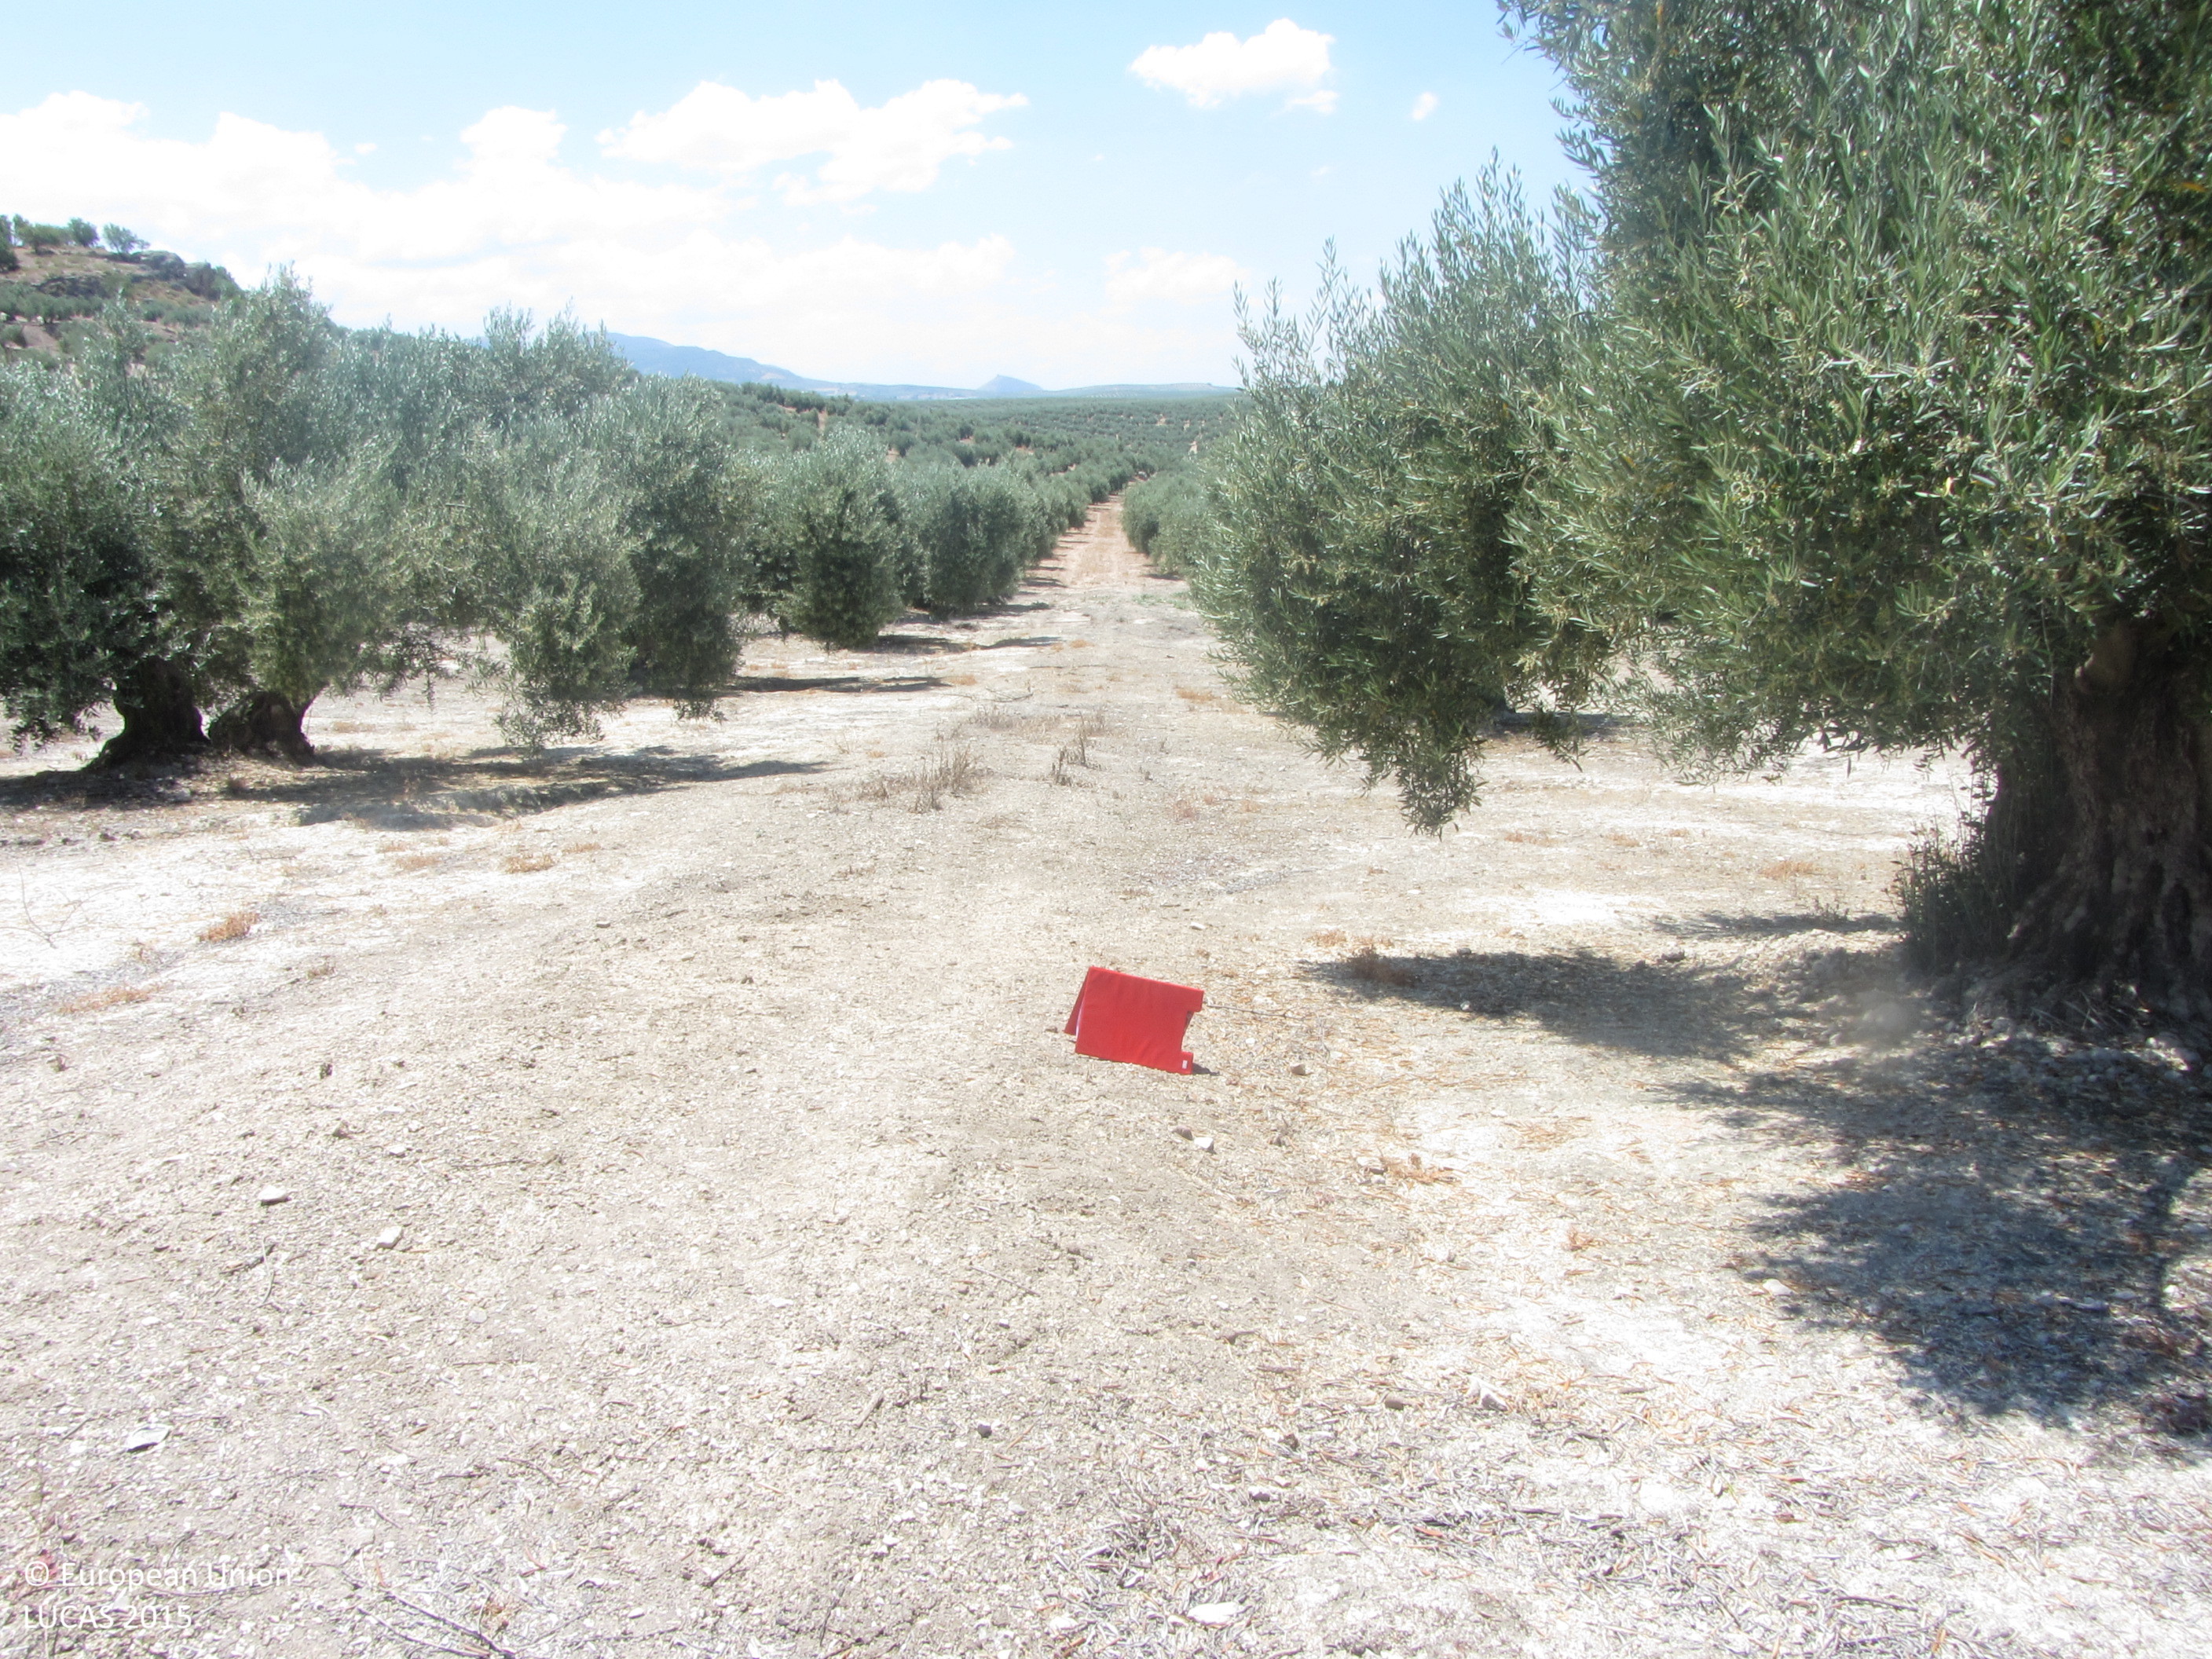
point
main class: Cropland
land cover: Olive groves
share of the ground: 25 - 50 %
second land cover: Other bare soil
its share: > 75 %
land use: Agriculture (excluding fallow land and kitchen gardens)
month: June
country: ES
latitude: 37.8303
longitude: -3.8523
